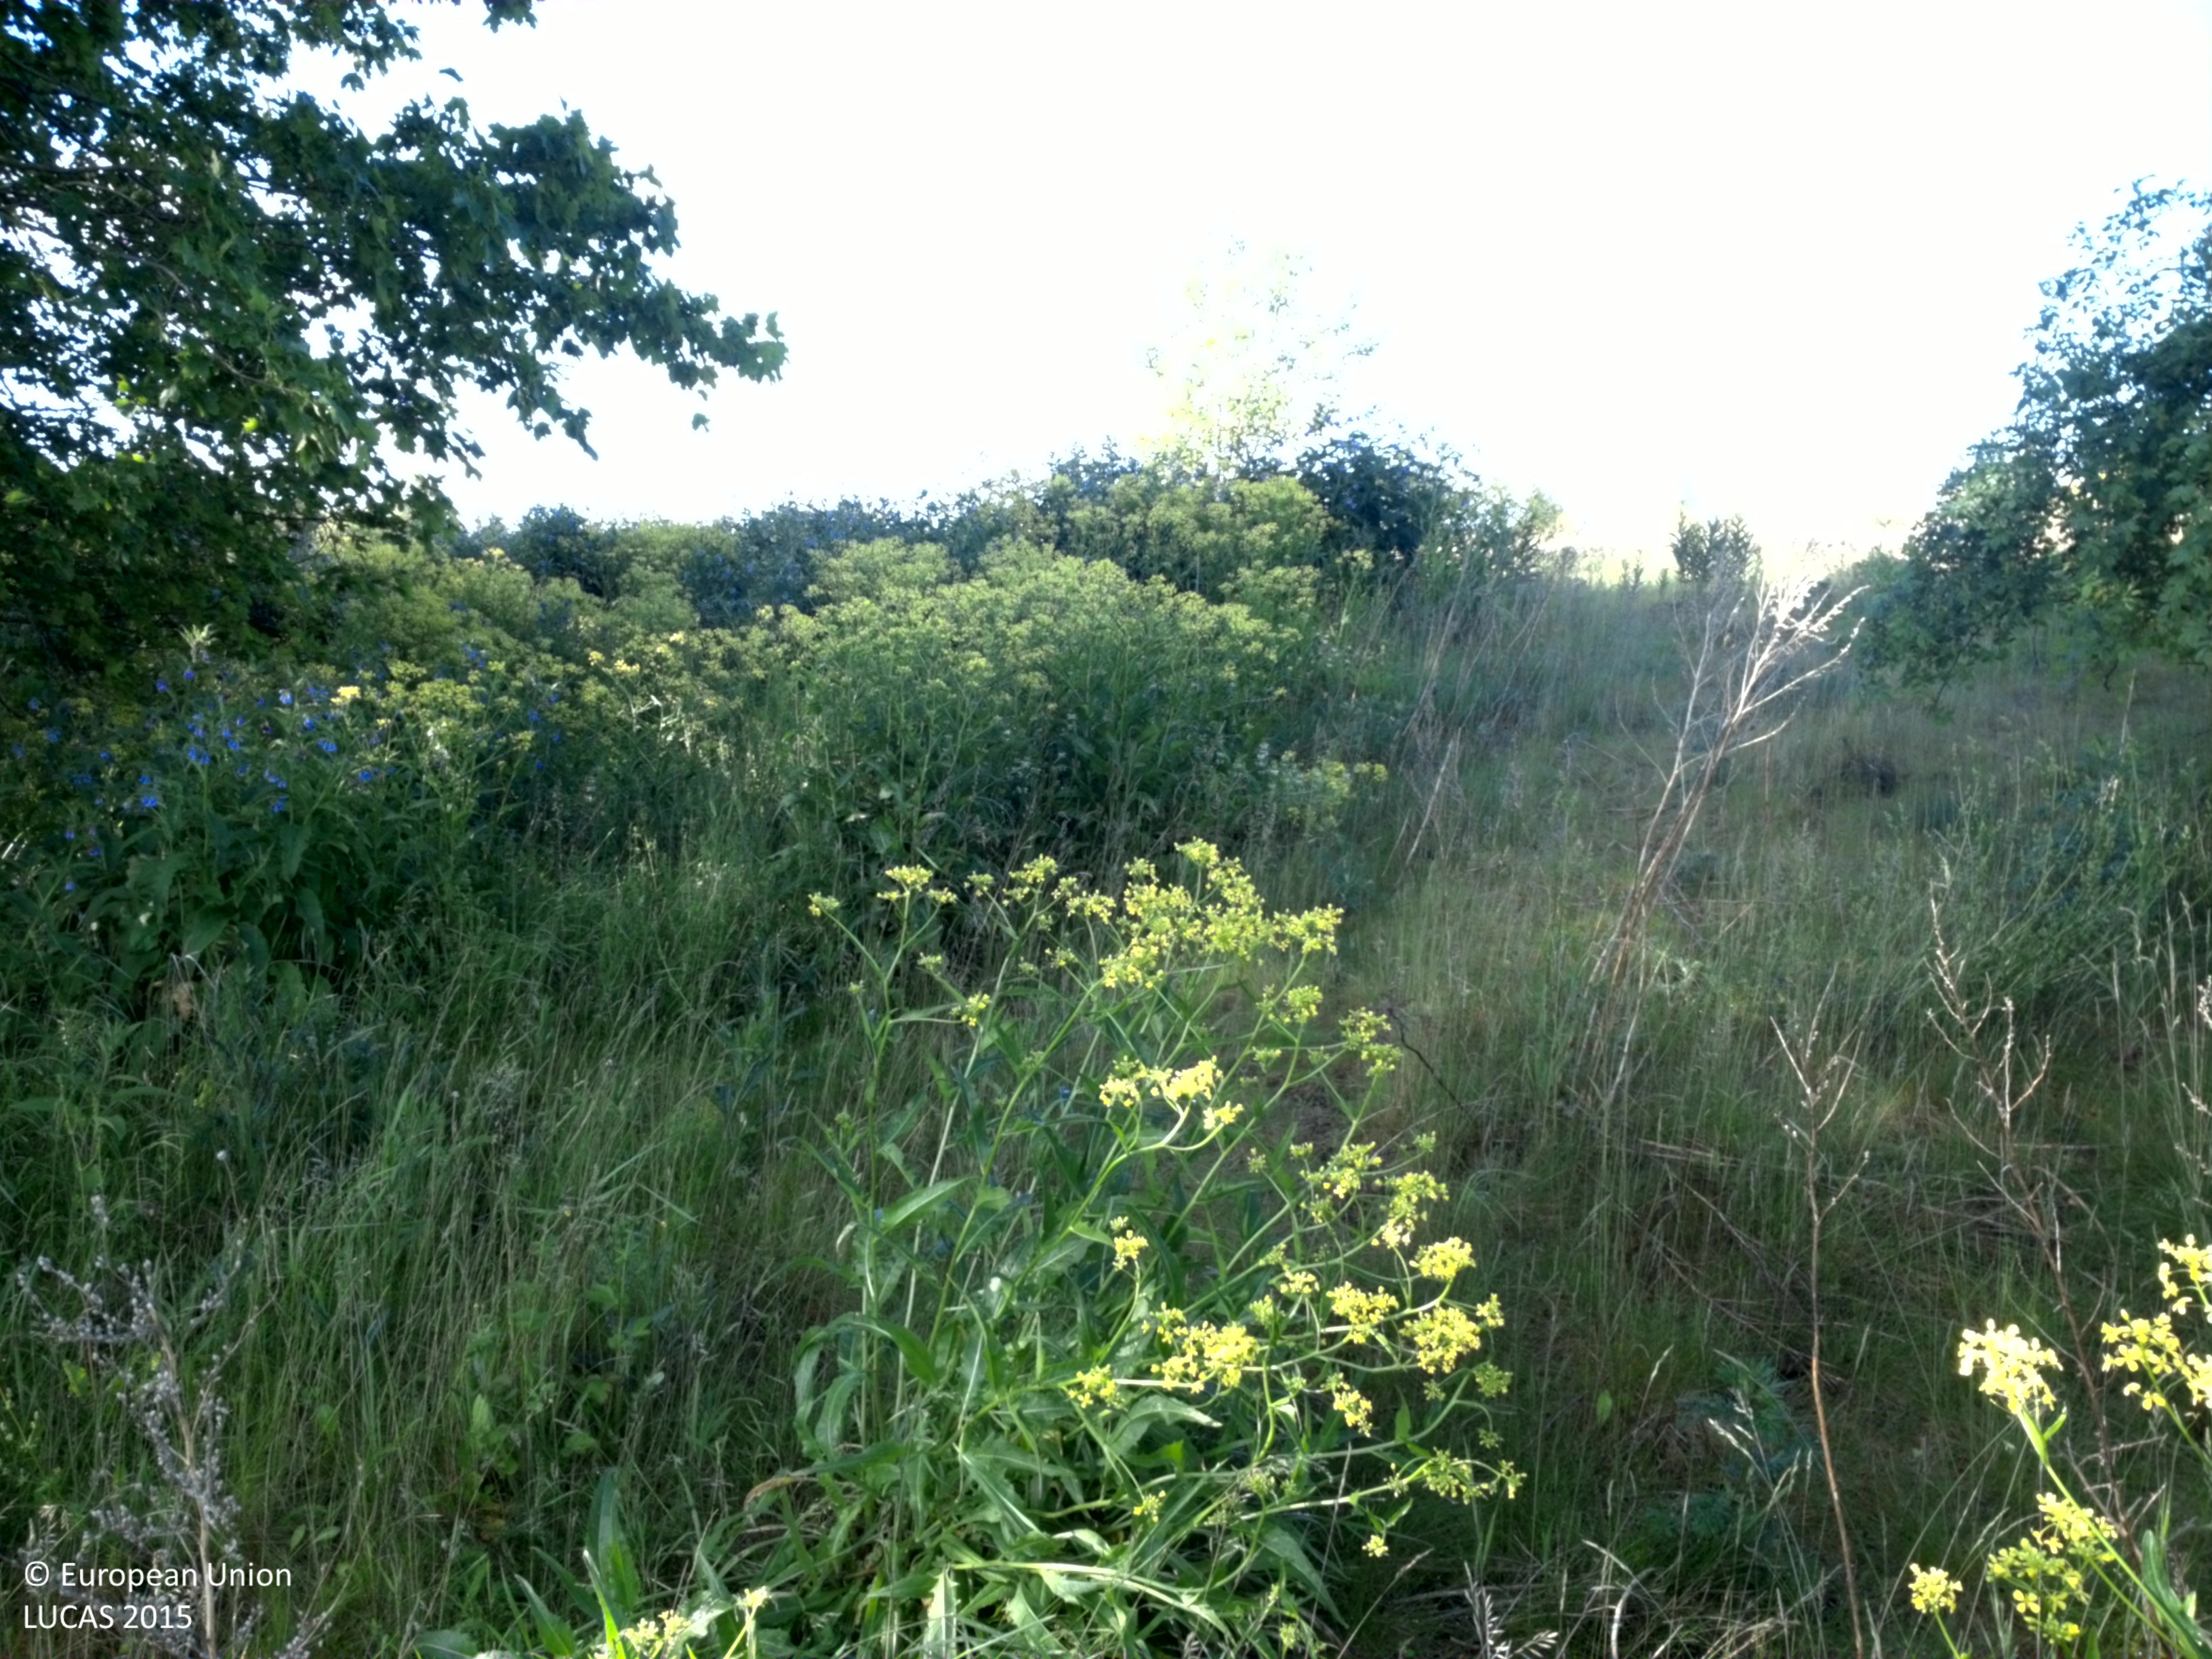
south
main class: Grassland
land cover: Grassland without tree/shrub cover
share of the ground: > 75 %
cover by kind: herbaceous plants 95 %, shrubs 5 %
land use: Semi-natural and natural areas not in use
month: June
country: SE
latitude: 59.8839
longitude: 17.6237
